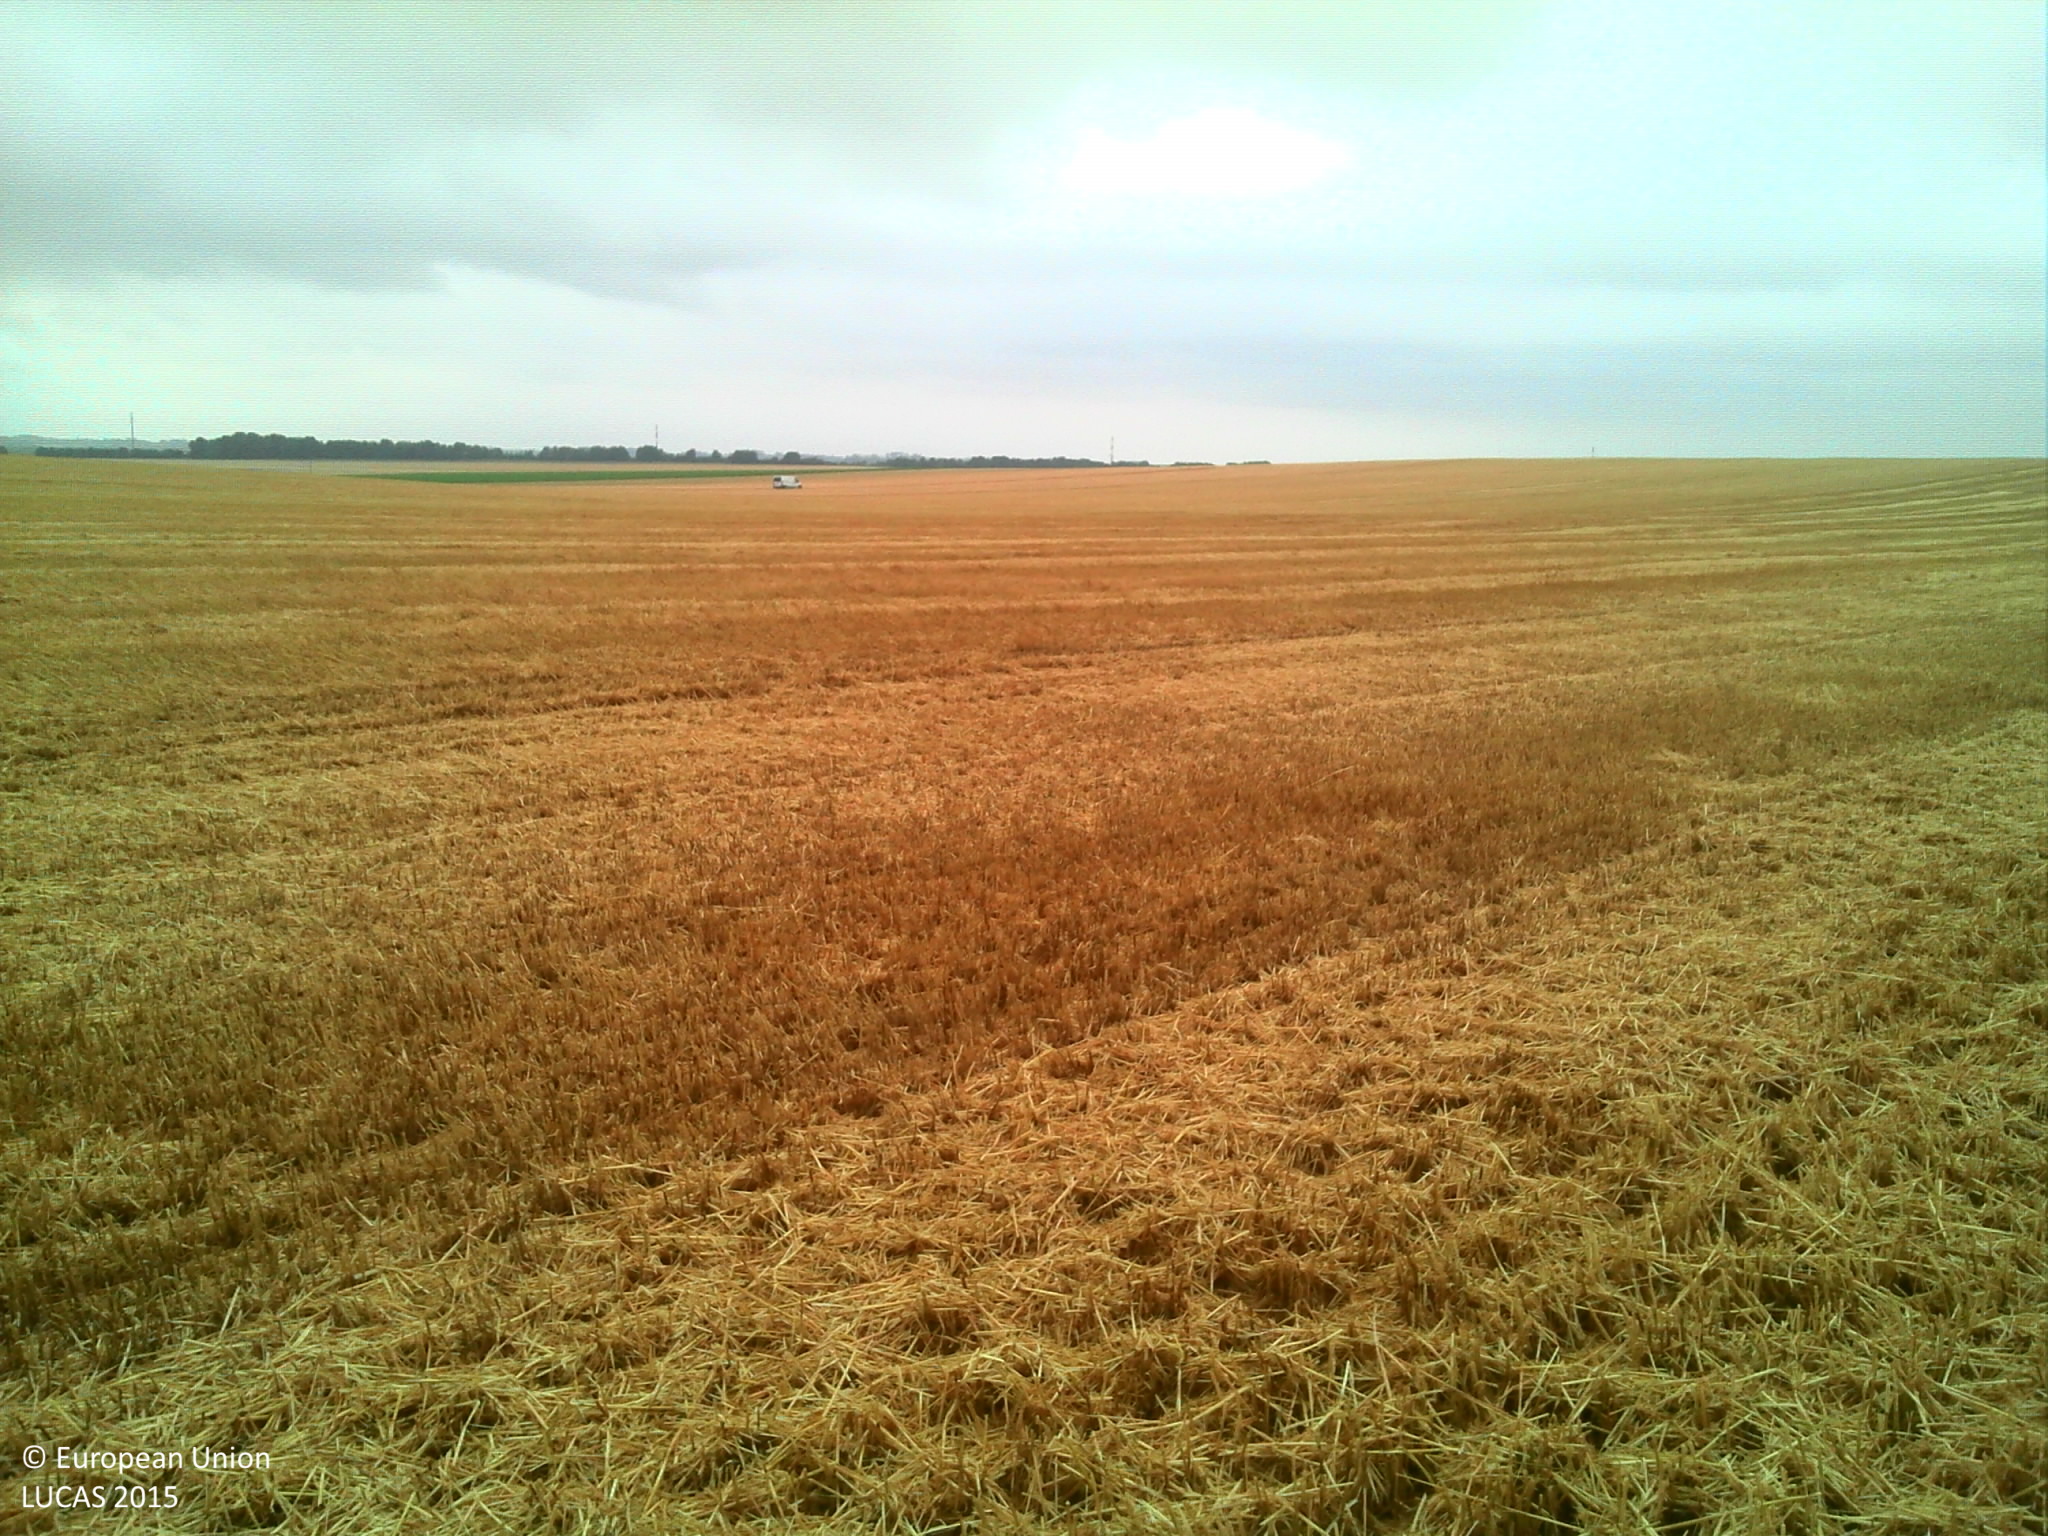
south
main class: Cropland
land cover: Common wheat
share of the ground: > 75 %
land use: Agriculture (excluding fallow land and kitchen gardens)
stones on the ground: < 10 %
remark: Harvested field
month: July
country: FR
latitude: 48.7337
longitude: 3.7811
